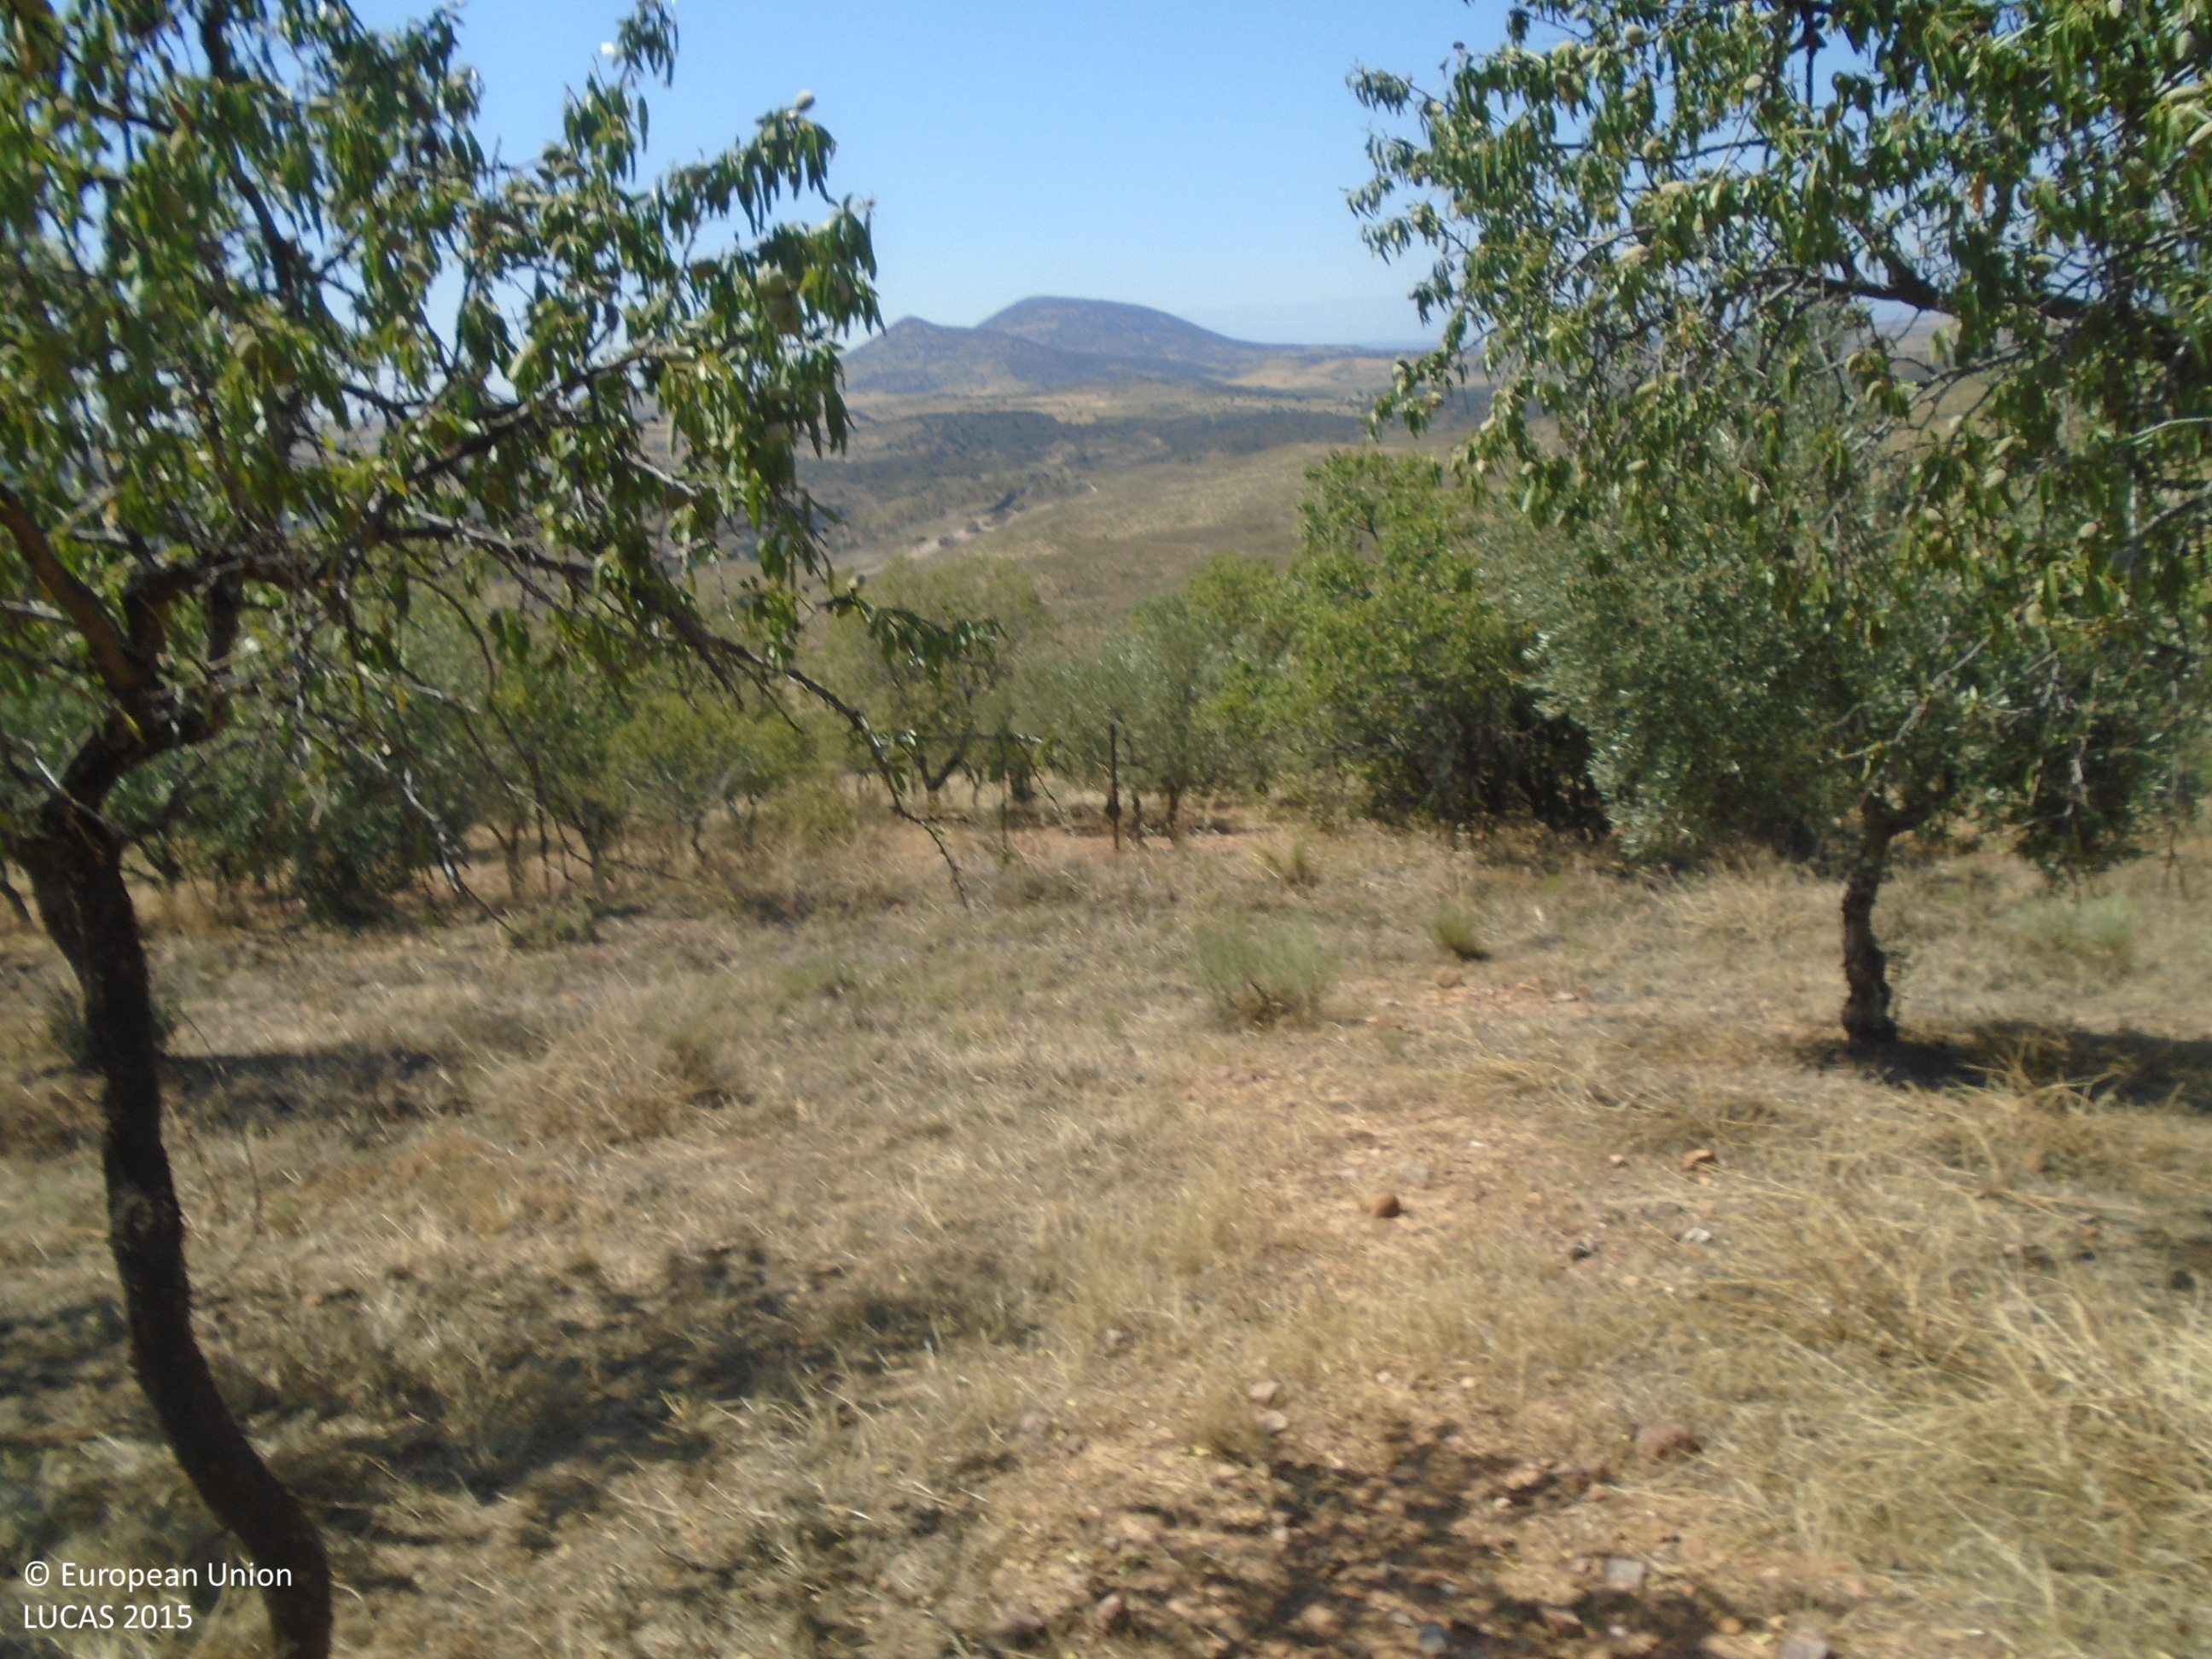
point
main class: Cropland
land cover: Olive groves
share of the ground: 10 - 25 %
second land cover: Spontaneously vegetated surfaces
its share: > 75 %
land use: Agriculture (excluding fallow land and kitchen gardens)
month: July
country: ES
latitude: 39.6543
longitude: -5.0226
